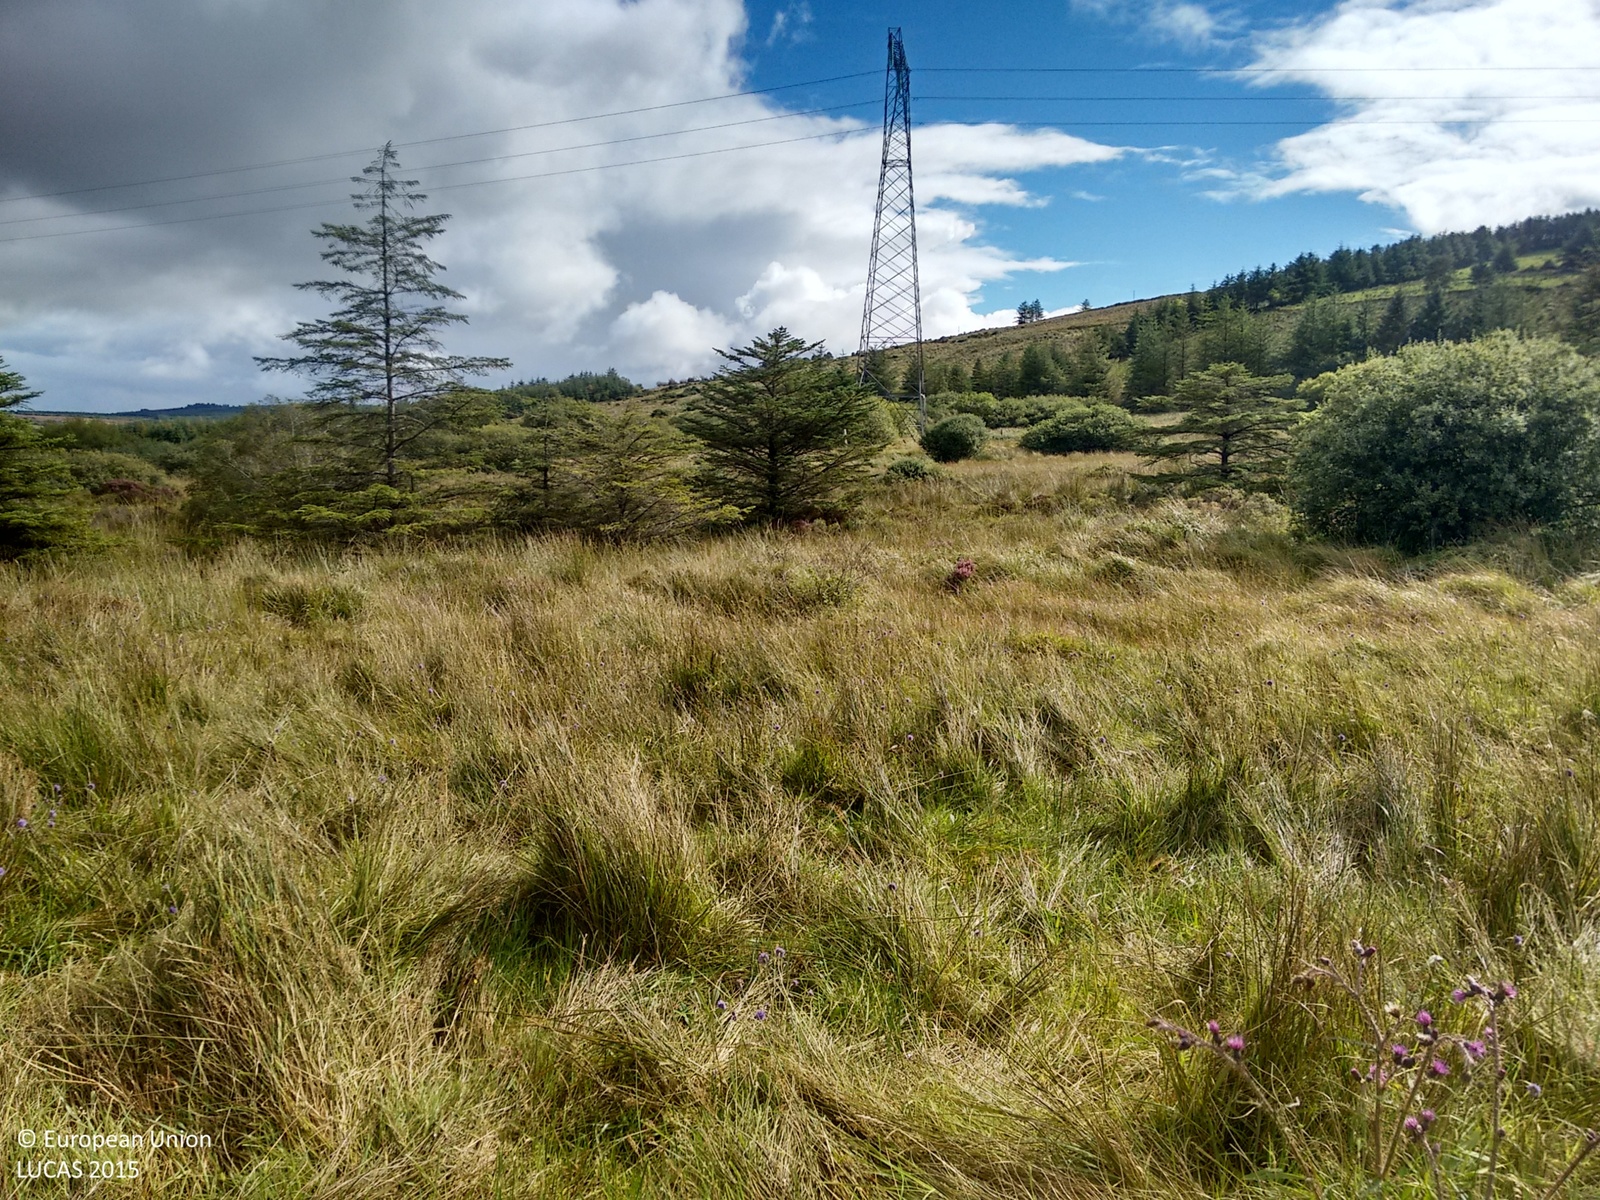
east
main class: Grassland
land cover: Grassland without tree/shrub cover
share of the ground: > 75 %
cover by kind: herbaceous plants 95 %, shrubs 5 %
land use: Agriculture (excluding fallow land and kitchen gardens)
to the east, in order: Grassland without tree/shrub cover; Spruce dominated coniferous woodland; Peatbogs; Rivers and streams; Grassland with sparse tree/shrub cover; Peatbogs; Grassland with sparse tree/shrub cover; Broadleaved woodland; Grassland without tree/shrub cover; Electric lines; Grassland with sparse tree/shrub cover; Fences; Peatbogs
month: September
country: IE
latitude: 52.2755
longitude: -9.3839
